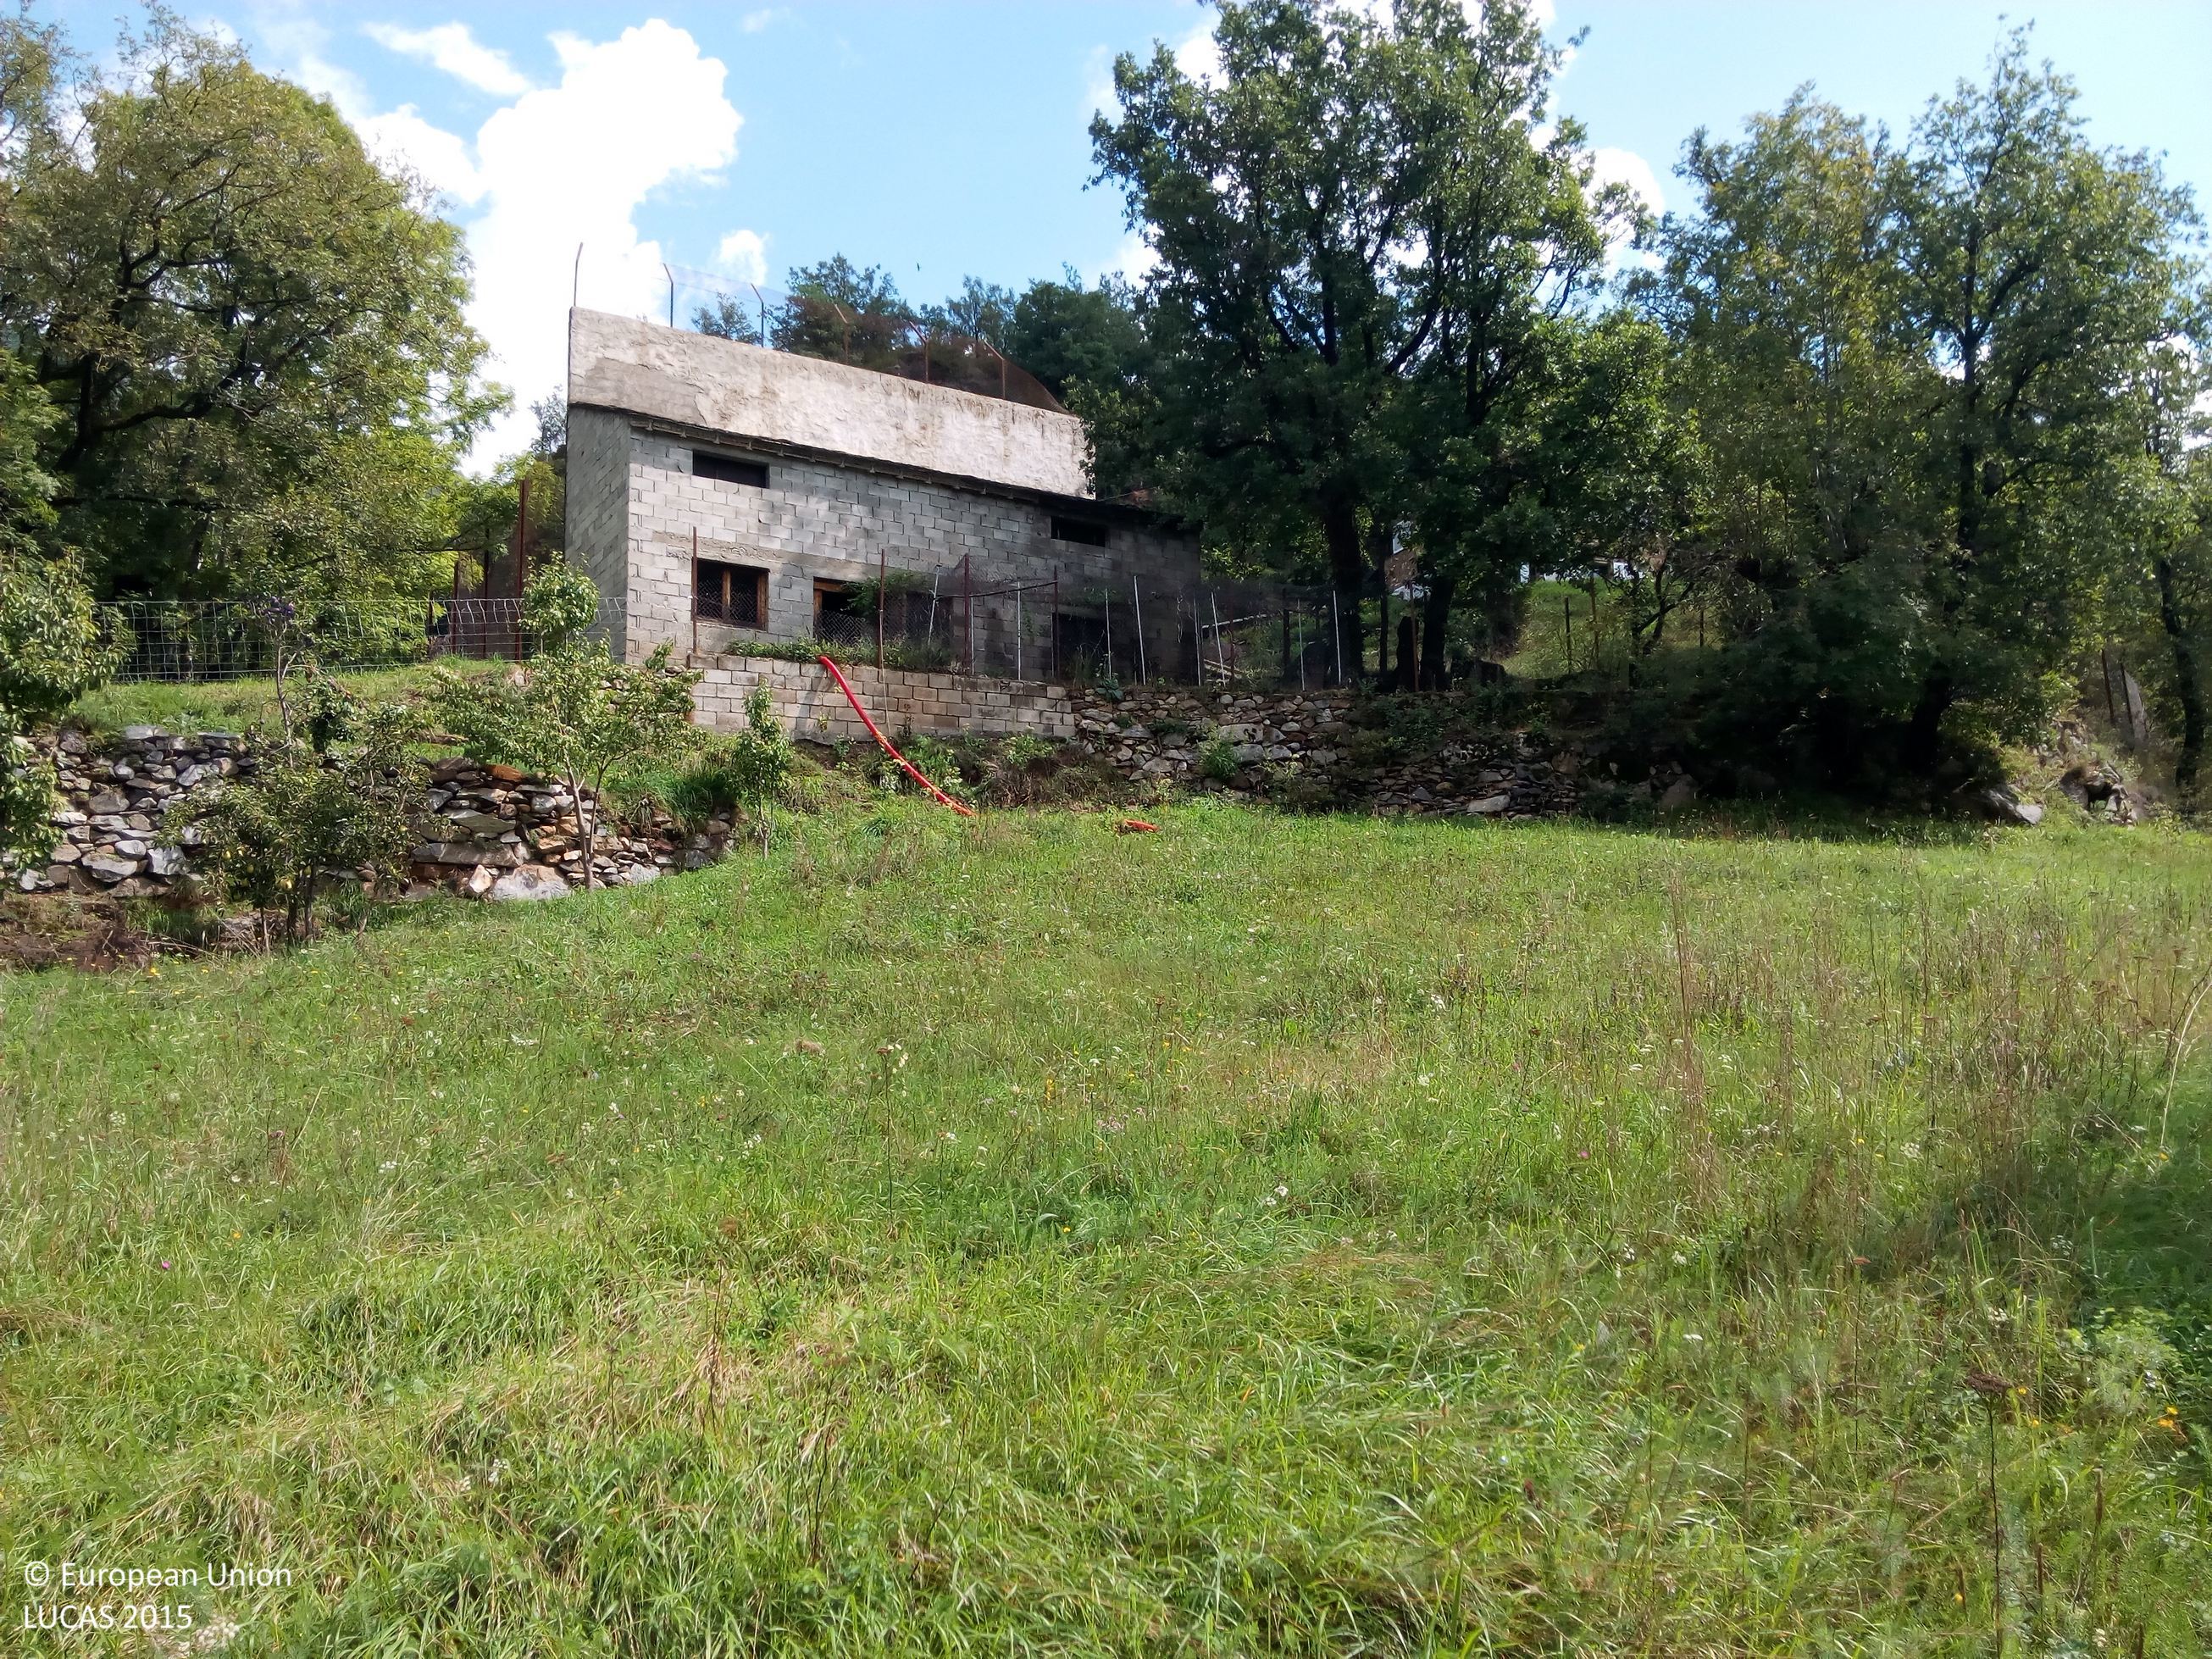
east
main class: Grassland
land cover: Grassland without tree/shrub cover
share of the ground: > 75 %
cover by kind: herbaceous plants 100 %
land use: Agriculture (excluding fallow land and kitchen gardens)
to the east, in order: Grassland without tree/shrub cover; Dry stone walls; Artificial constructions in urban areas; Grassland without tree/shrub cover; Groves; Tracks; Broadleaved woodland; Grassland without tree/shrub cover; Broadleaved woodland; Shrubland without tree cover; Pine dominated mixed woodland
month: September
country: ES
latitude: 42.5489
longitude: 0.4688
